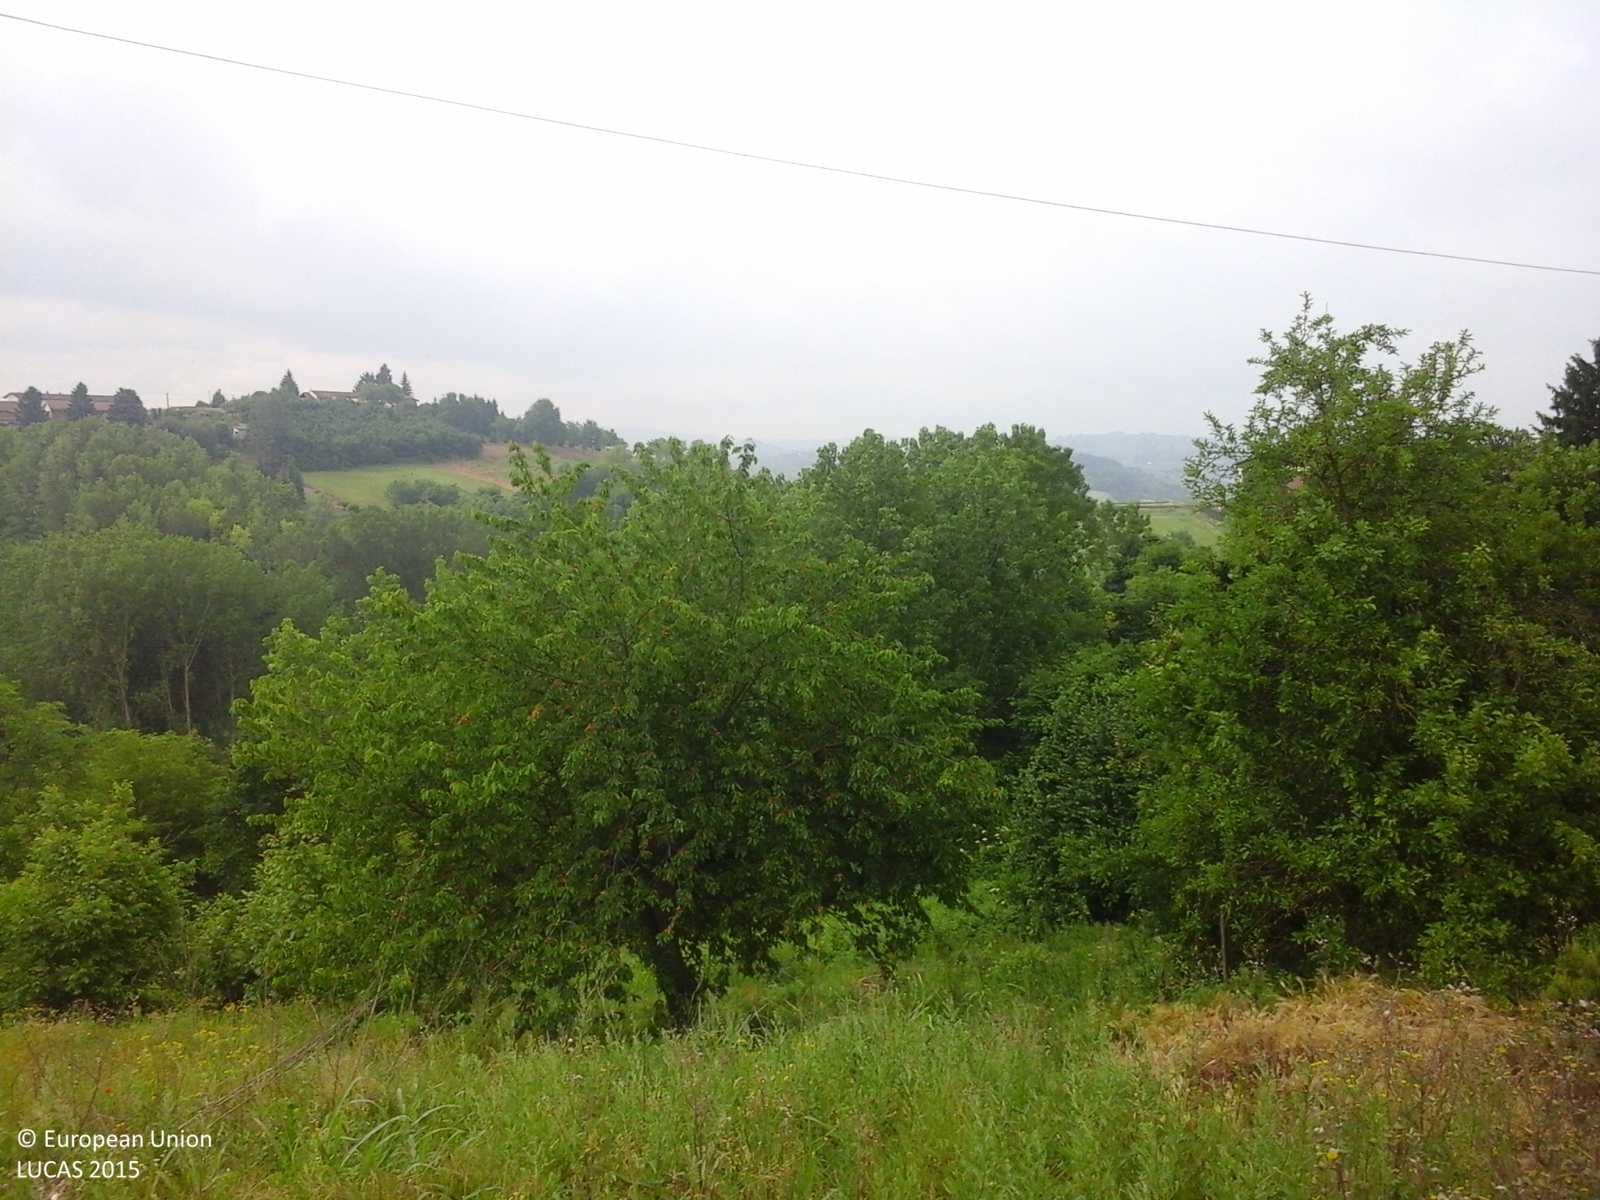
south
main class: Grassland
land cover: Spontaneously vegetated surfaces
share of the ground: > 75 %
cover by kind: herbaceous plants 100 %
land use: Fallow land
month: May
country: IT
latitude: 44.8403
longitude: 8.2197
